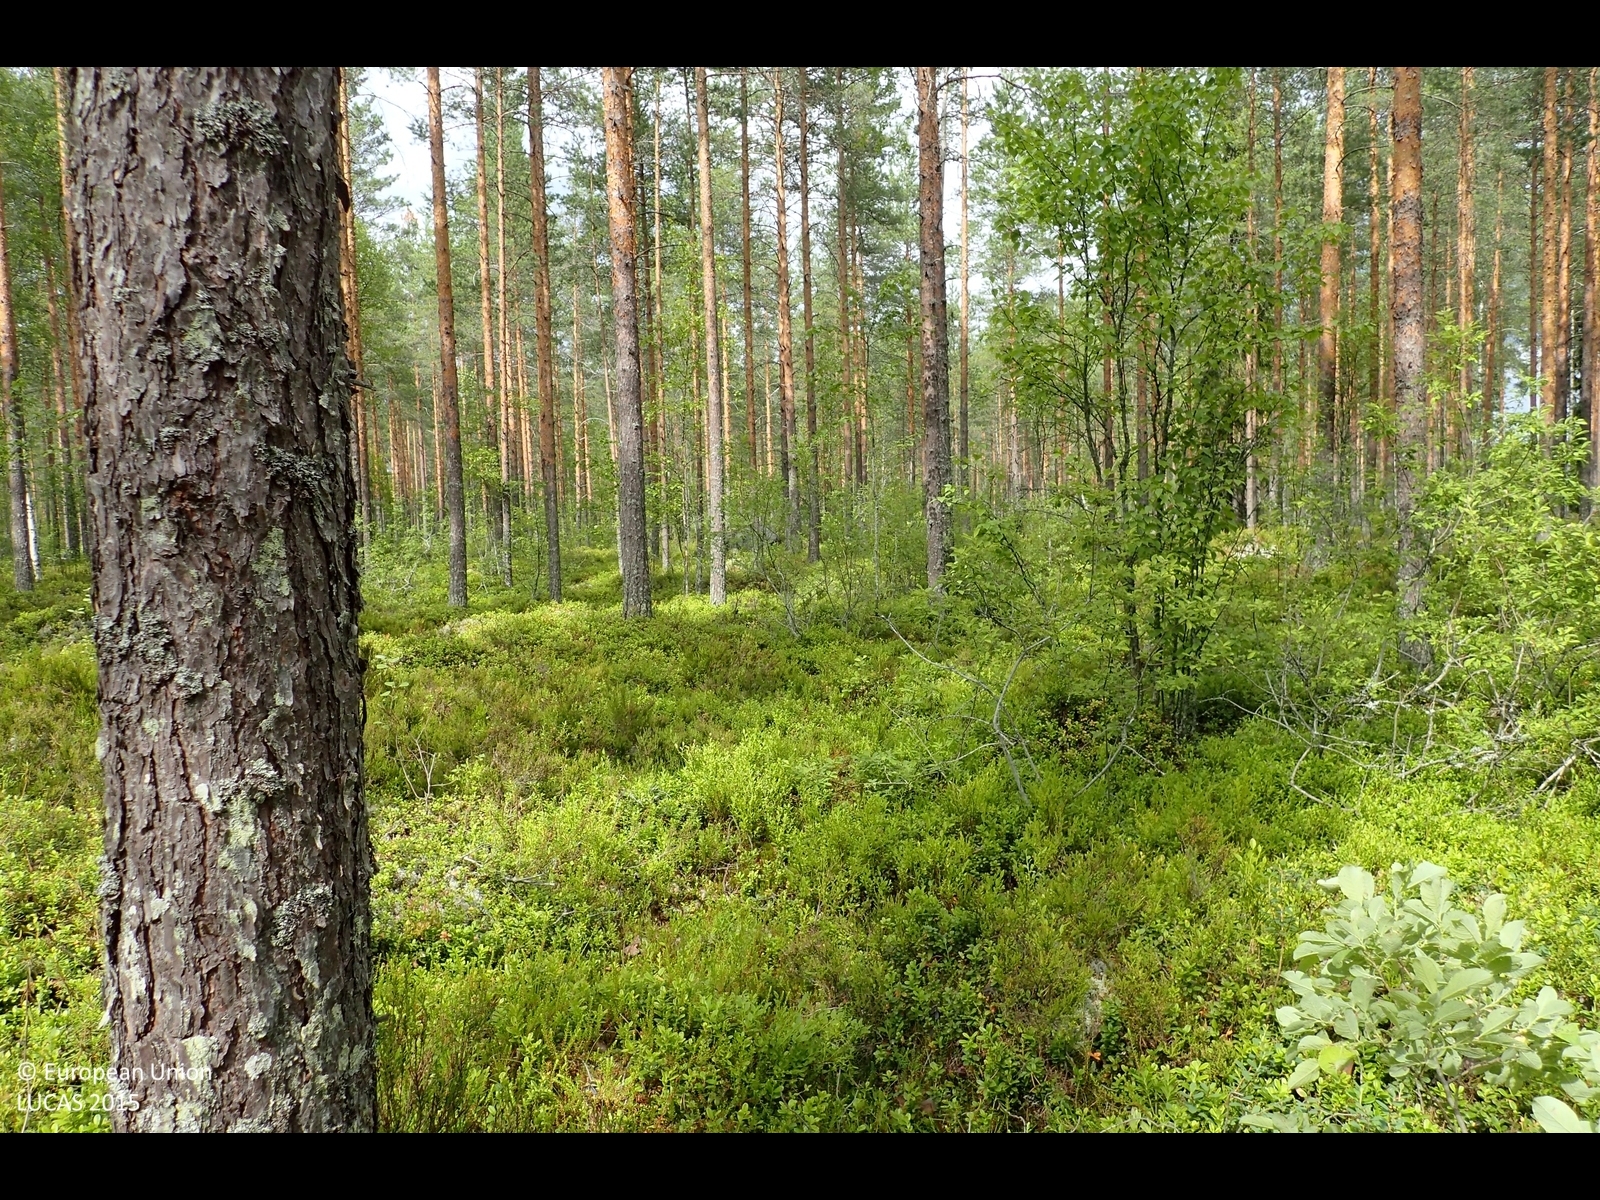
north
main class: Woodland
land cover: Pine dominated coniferous woodland
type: boreal forest
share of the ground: 50 - 75 %
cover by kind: coniferous forest trees 45 %, shrubs 45 %, broadleaved forest trees 5 %, lichens and mosses 5 %
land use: Forestry
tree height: > 5 m
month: July
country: FI
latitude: 62.6067
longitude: 23.4933
